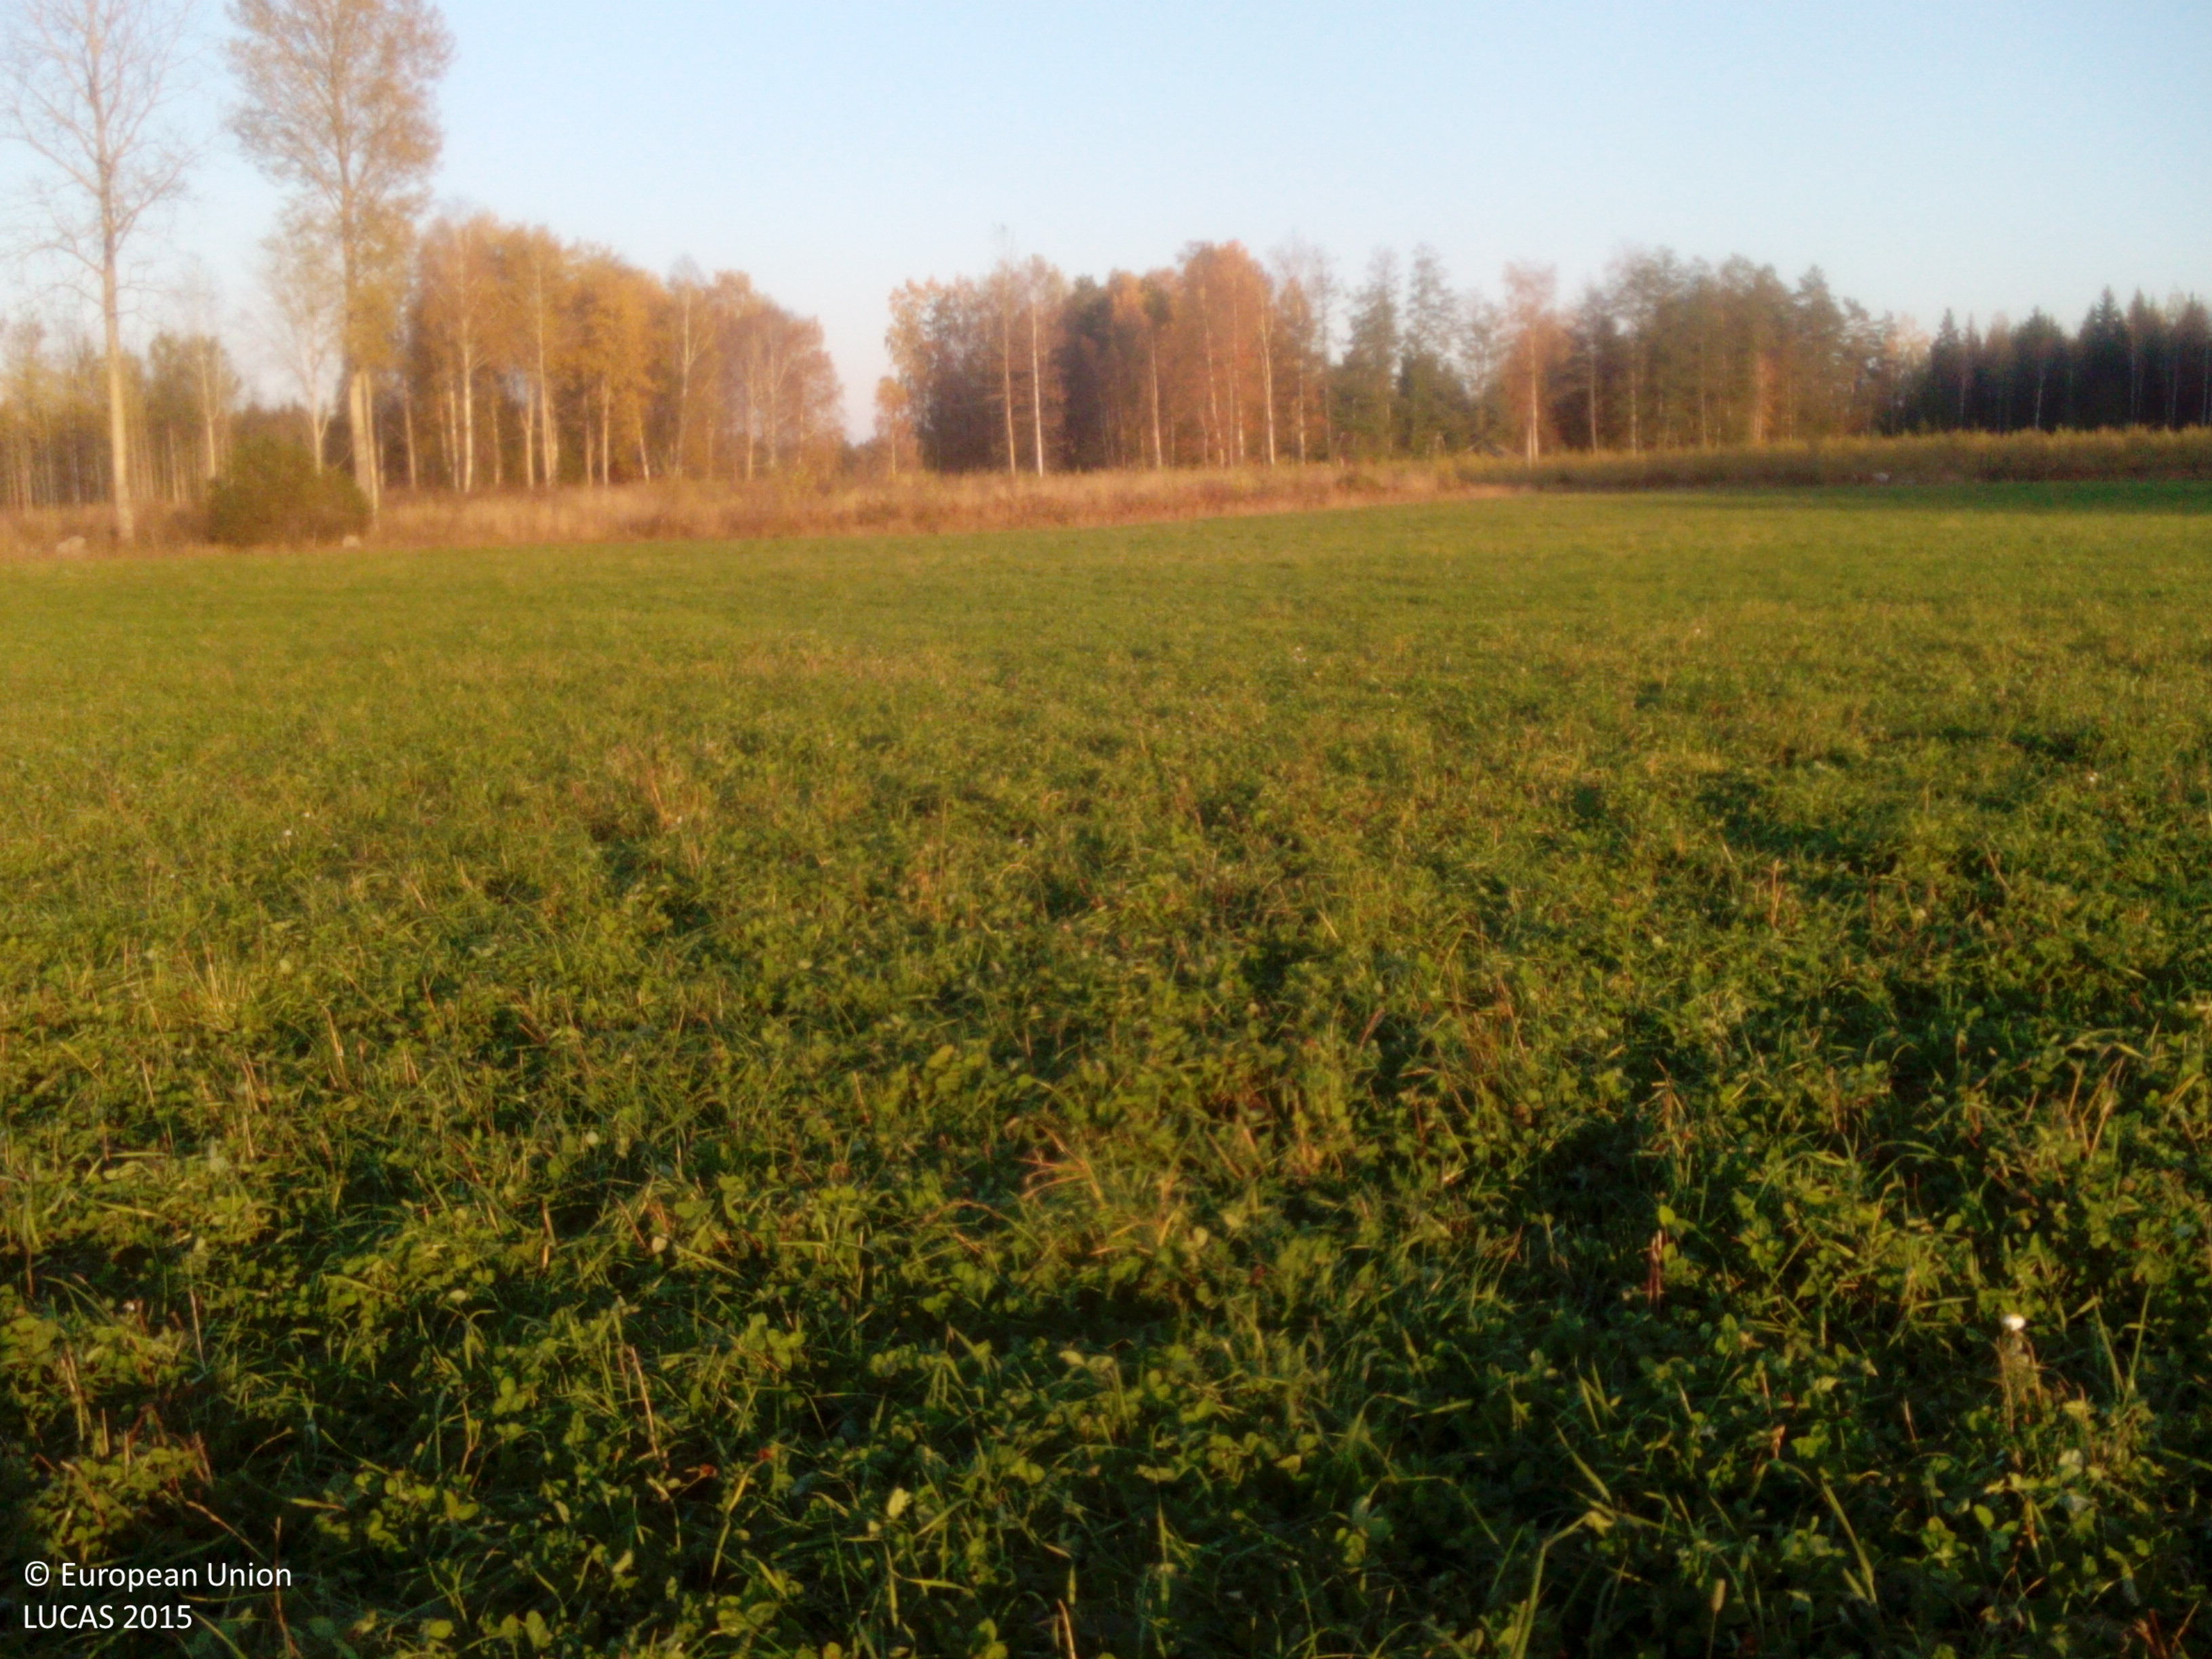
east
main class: Cropland
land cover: Clovers
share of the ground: > 75 %
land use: Agriculture (excluding fallow land and kitchen gardens)
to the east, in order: Clovers; Ditches and canals; Broadleaved woodland; Ditches and canals; Broadleaved woodland
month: October
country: SE
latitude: 58.8797
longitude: 16.3956
